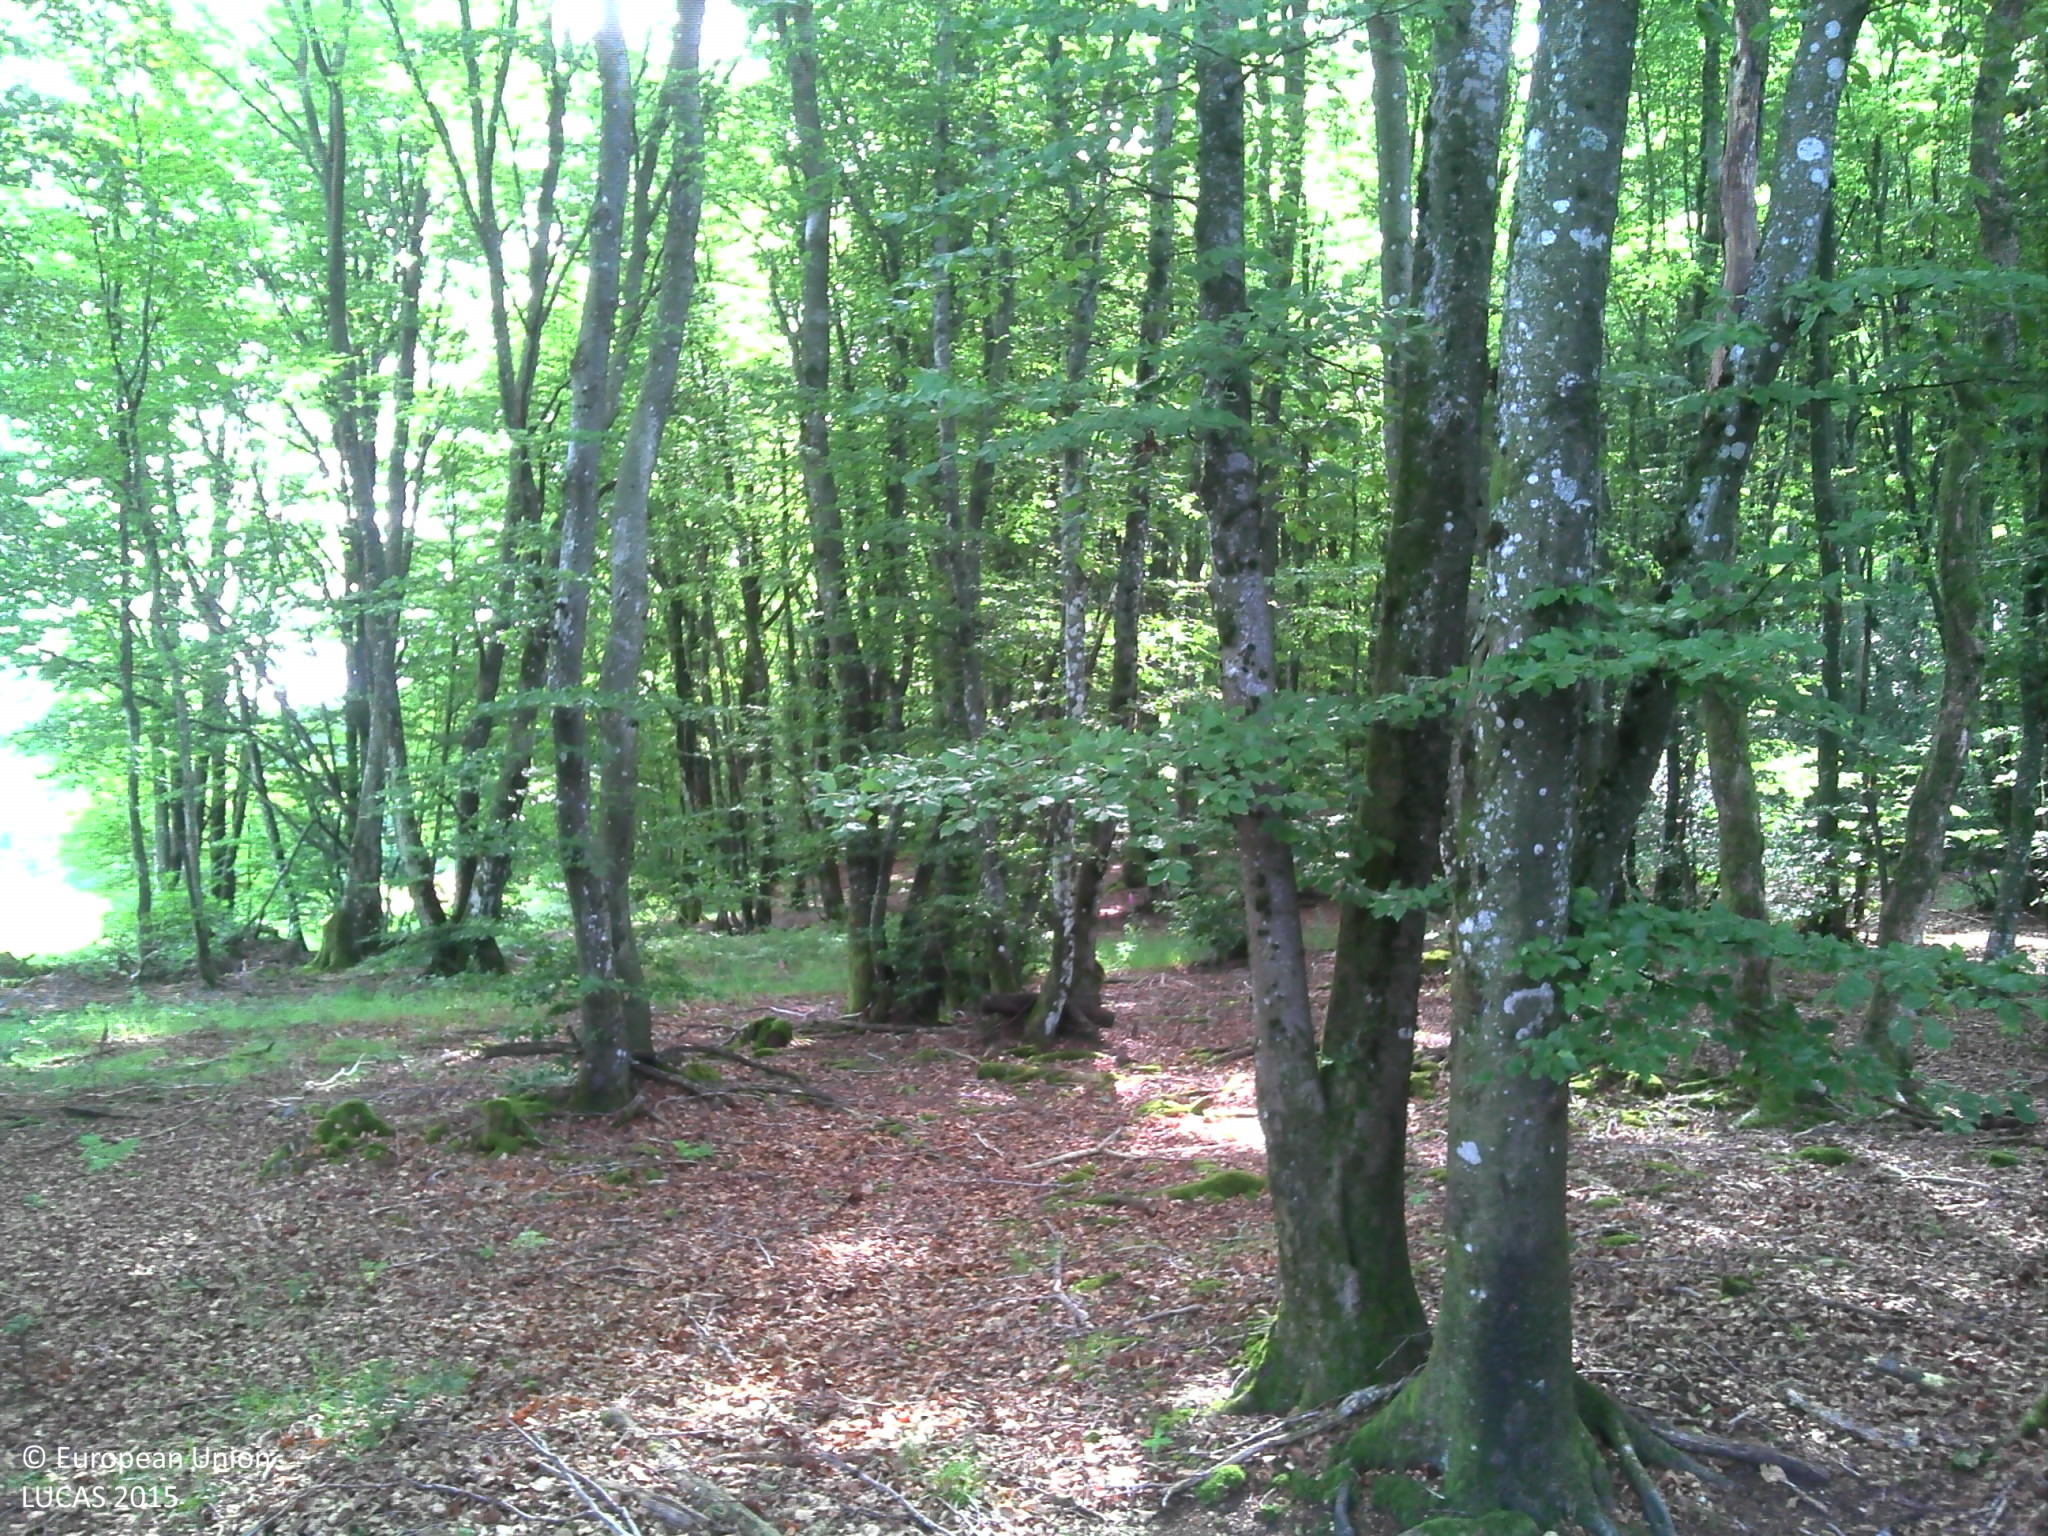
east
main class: Woodland
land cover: Spruce dominated mixed woodland
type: hemiboreal forest and nemoral coniferous forest and mixed broadleaved-coniferous forest
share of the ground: > 75 %
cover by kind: broadleaved forest trees 65 %, coniferous forest trees 25 %, herbaceous plants 5 %, lichens and mosses 5 %
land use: Forestry
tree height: > 5 m
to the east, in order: Spruce dominated mixed woodland; Broadleaved woodland; Tracks; Fences; Grassland without tree/shrub cover; Broadleaved woodland; Grassland without tree/shrub cover; Lines of trees; Grassland without tree/shrub cover
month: June
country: FR
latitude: 46.9588
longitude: 3.9936
